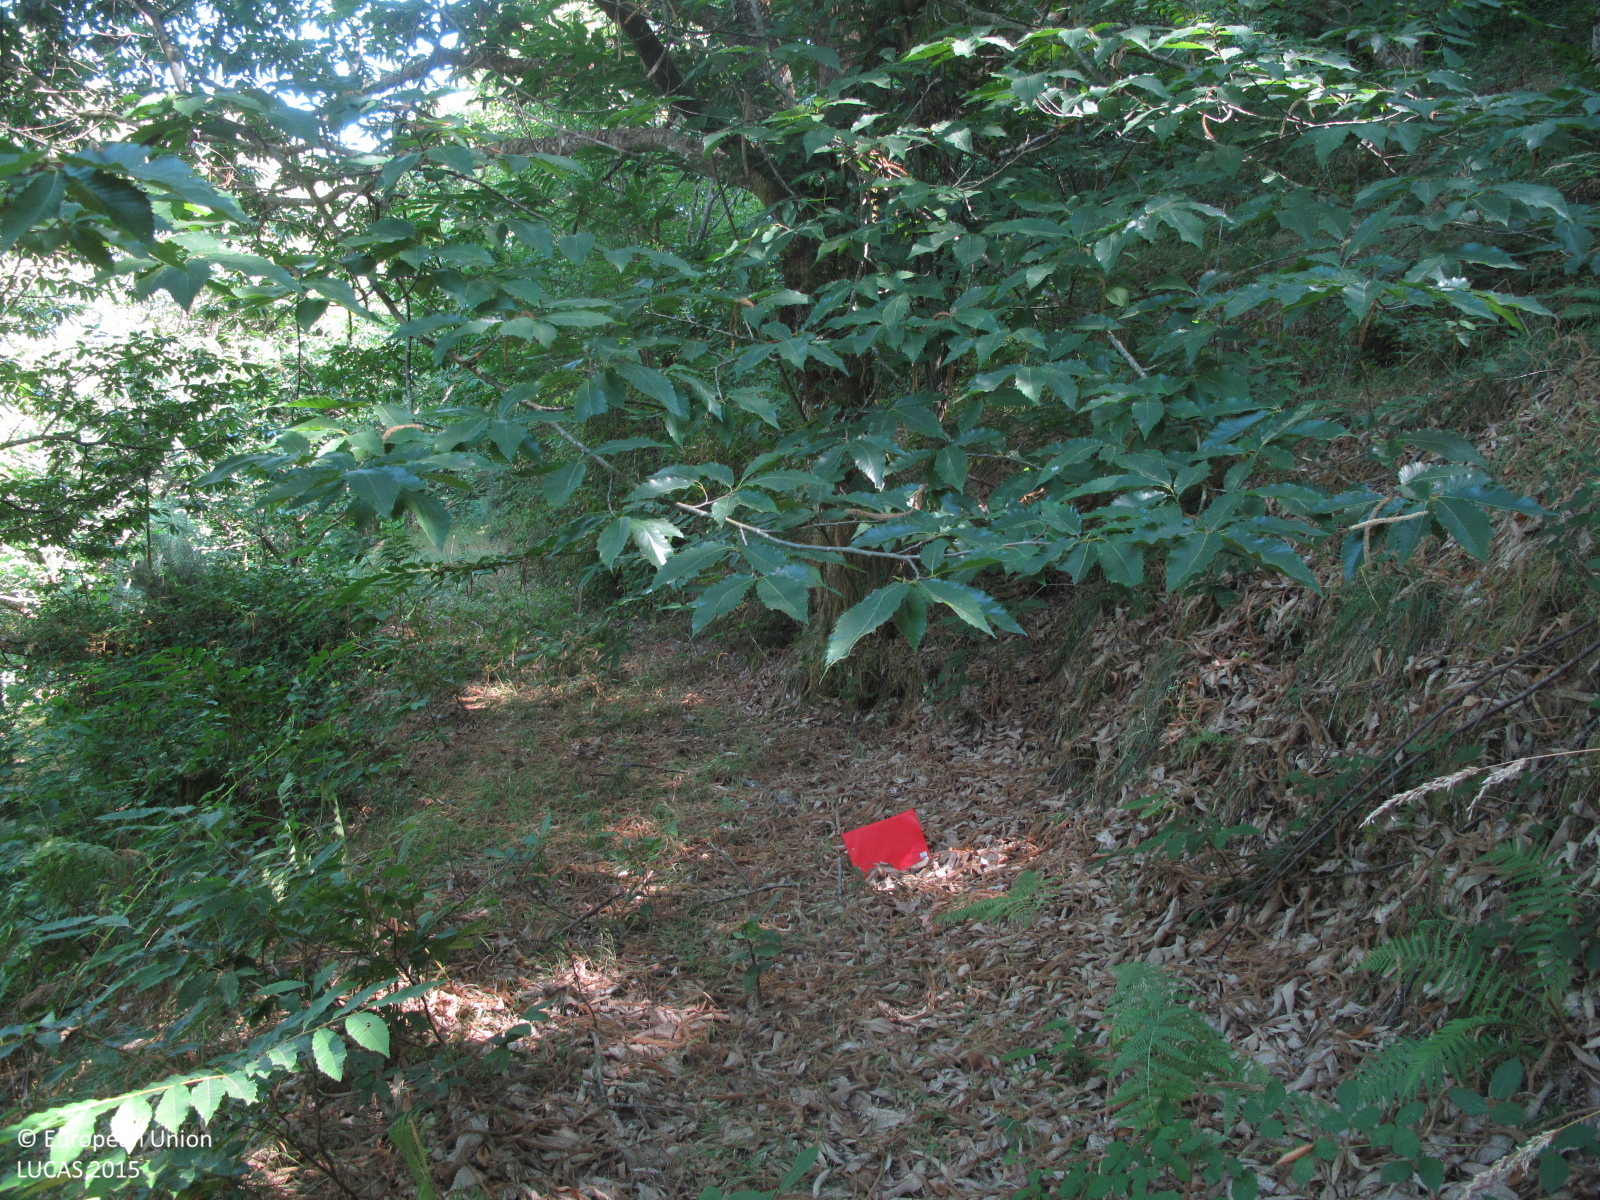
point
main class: Woodland
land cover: Broadleaved woodland
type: thermophilous deciduous forest
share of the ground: > 75 %
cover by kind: broadleaved forest trees 100 %
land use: Forestry
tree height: > 5 m
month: July
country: ES
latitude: 43.3213
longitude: -8.1640
